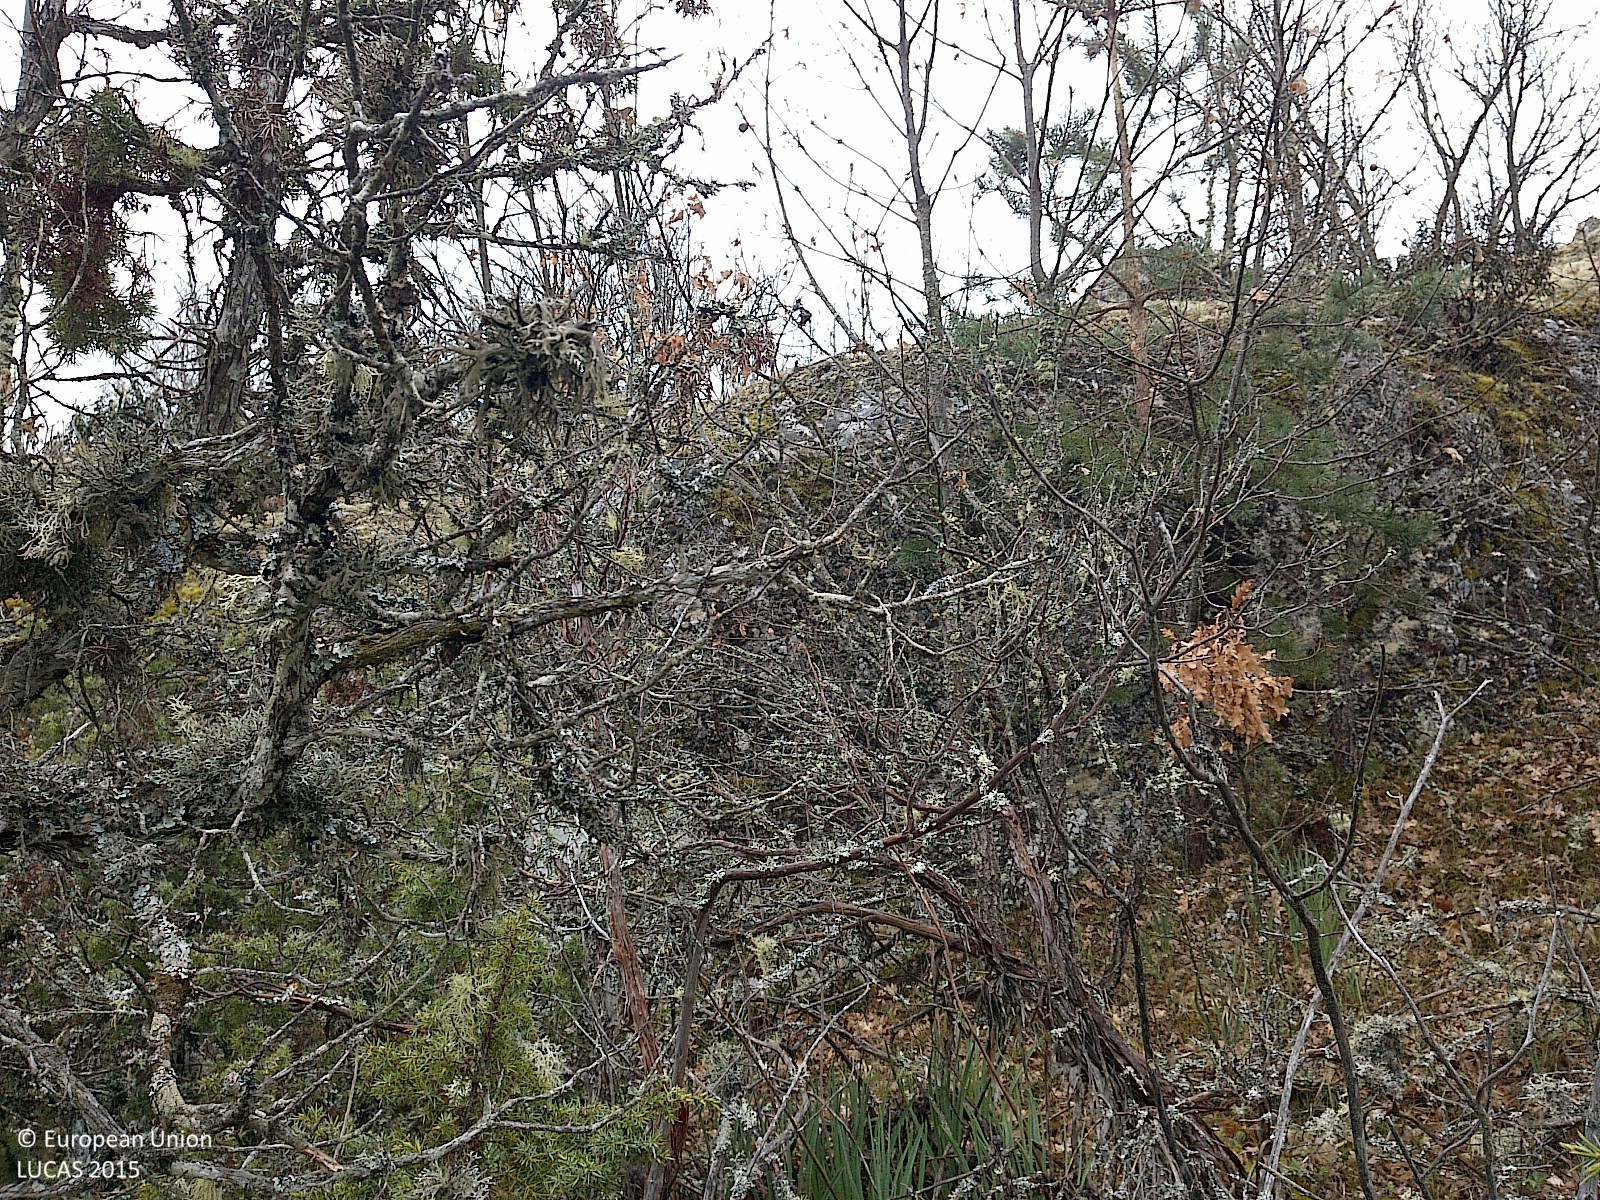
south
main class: Woodland
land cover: Broadleaved woodland
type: thermophilous deciduous forest
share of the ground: 25 - 50 %
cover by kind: shrubs 40 %, broadleaved forest trees 30 %, consolidated bare surface 15 %, herbaceous plants 10 %, coniferous forest trees 5 %
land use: Semi-natural and natural areas not in use
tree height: < 5 m
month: May
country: ES
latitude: 41.9345
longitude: -3.1825
